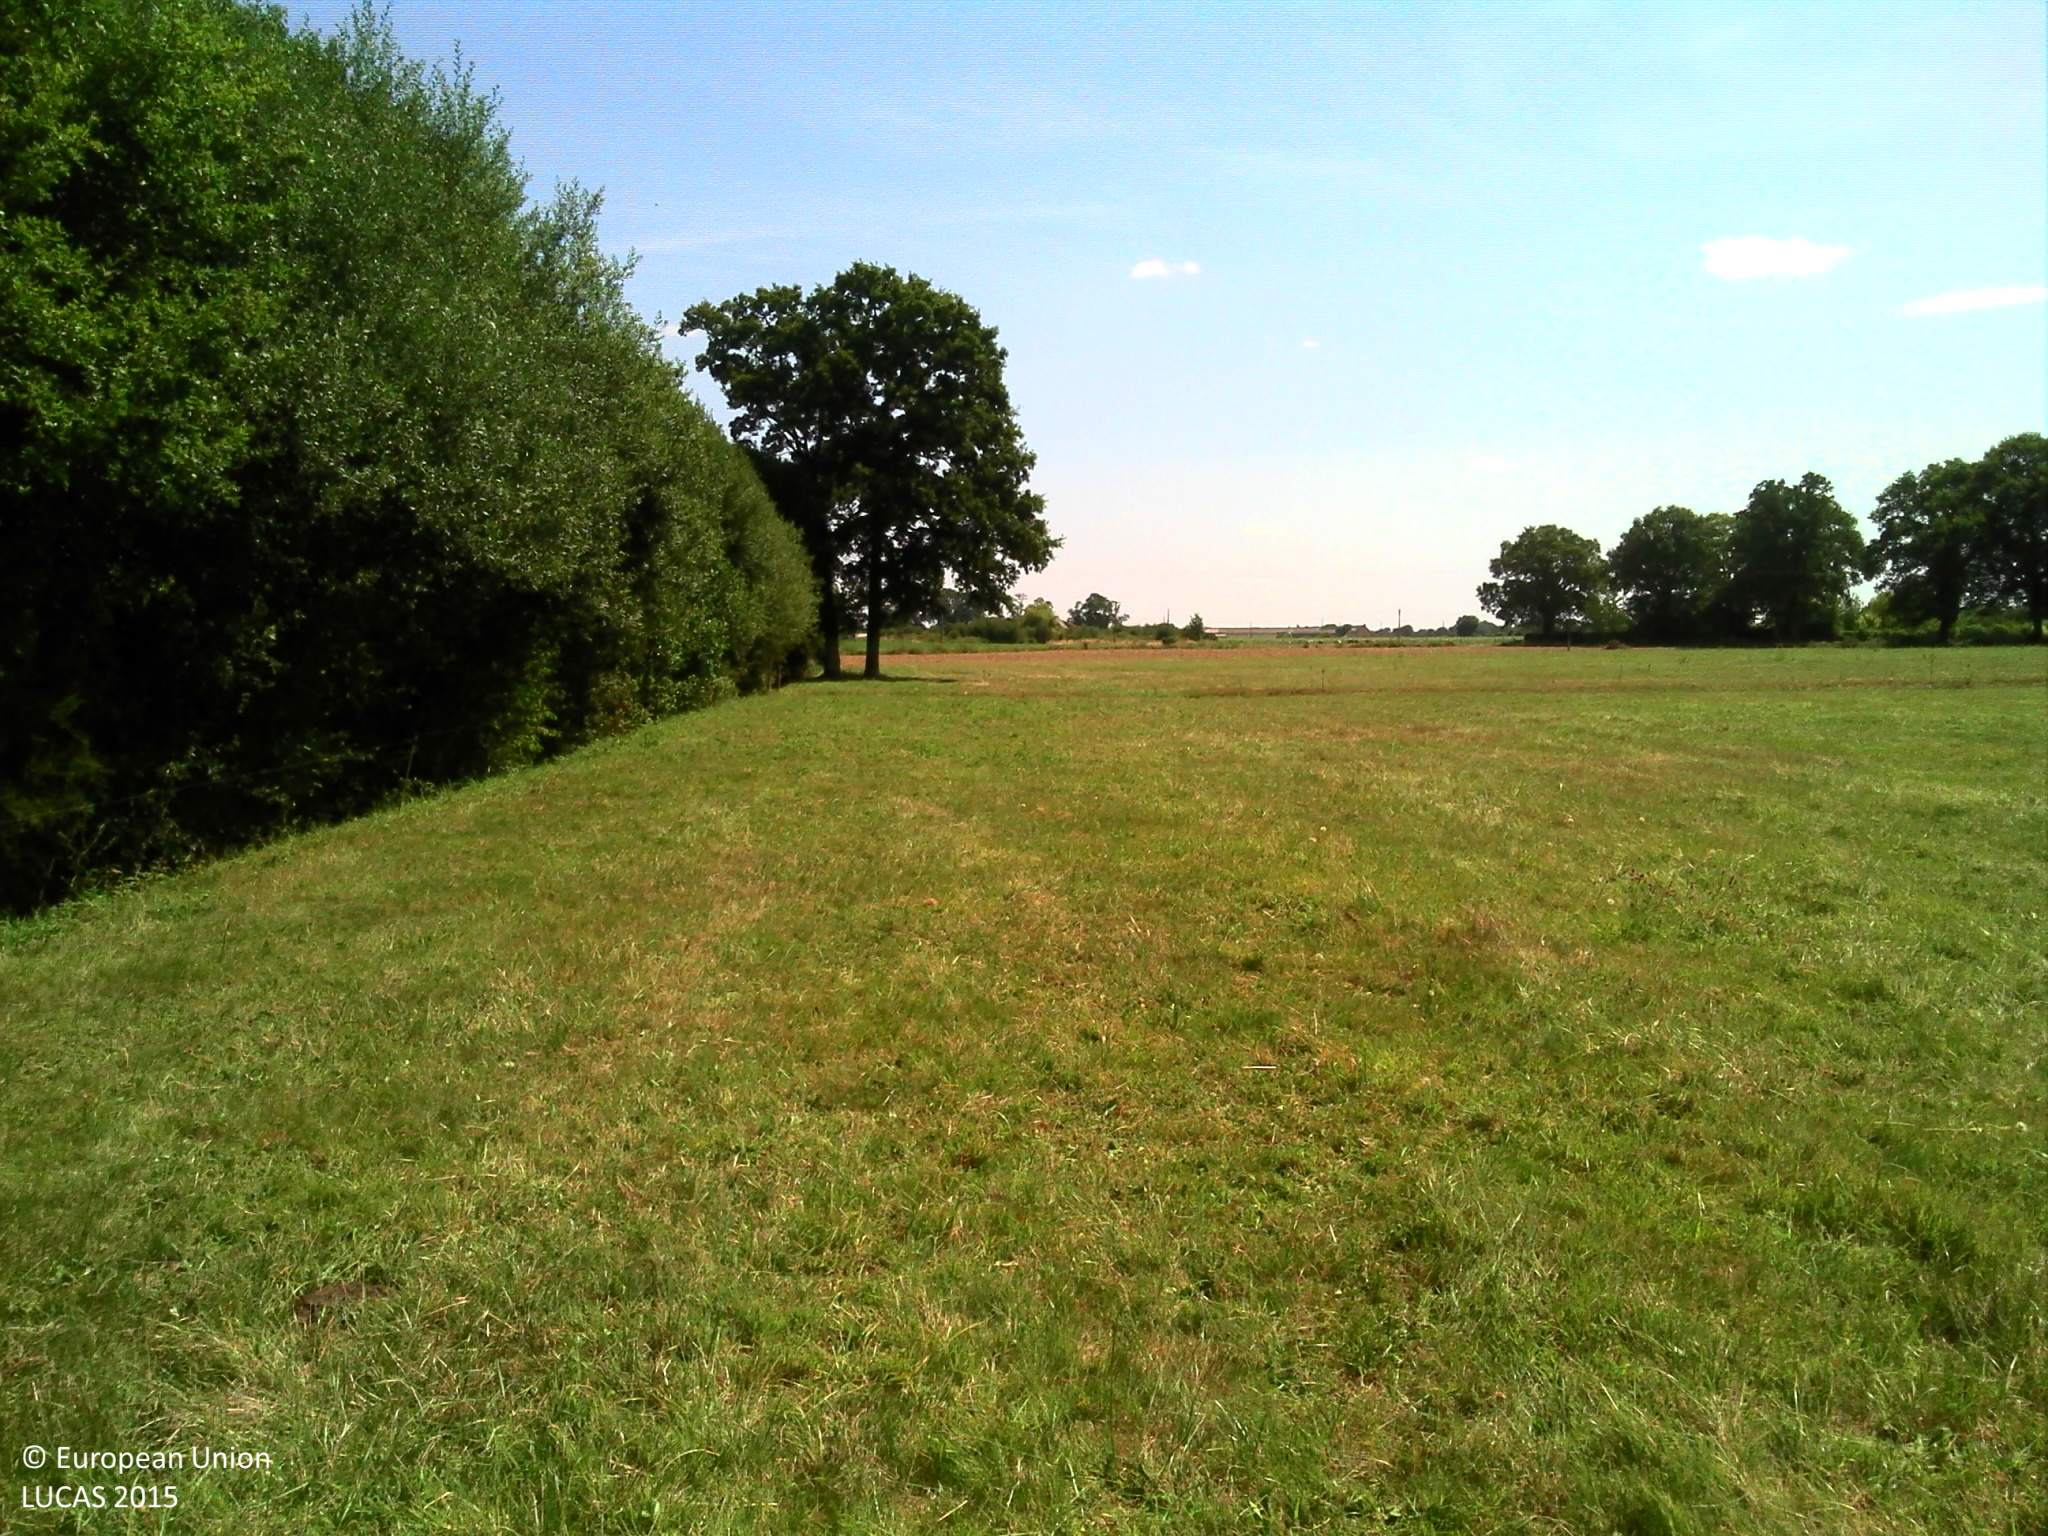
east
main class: Grassland
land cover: Grassland without tree/shrub cover
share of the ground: > 75 %
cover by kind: herbaceous plants 100 %
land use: Agriculture (excluding fallow land and kitchen gardens)
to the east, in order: Grassland without tree/shrub cover; Fences; Ditches and canals; Fences; Grassland without tree/shrub cover; Single bushes/trees; Grassland without tree/shrub cover; Fences; Ditches and canals; Common wheat
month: August
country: FR
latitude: 47.9272
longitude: -1.1625
